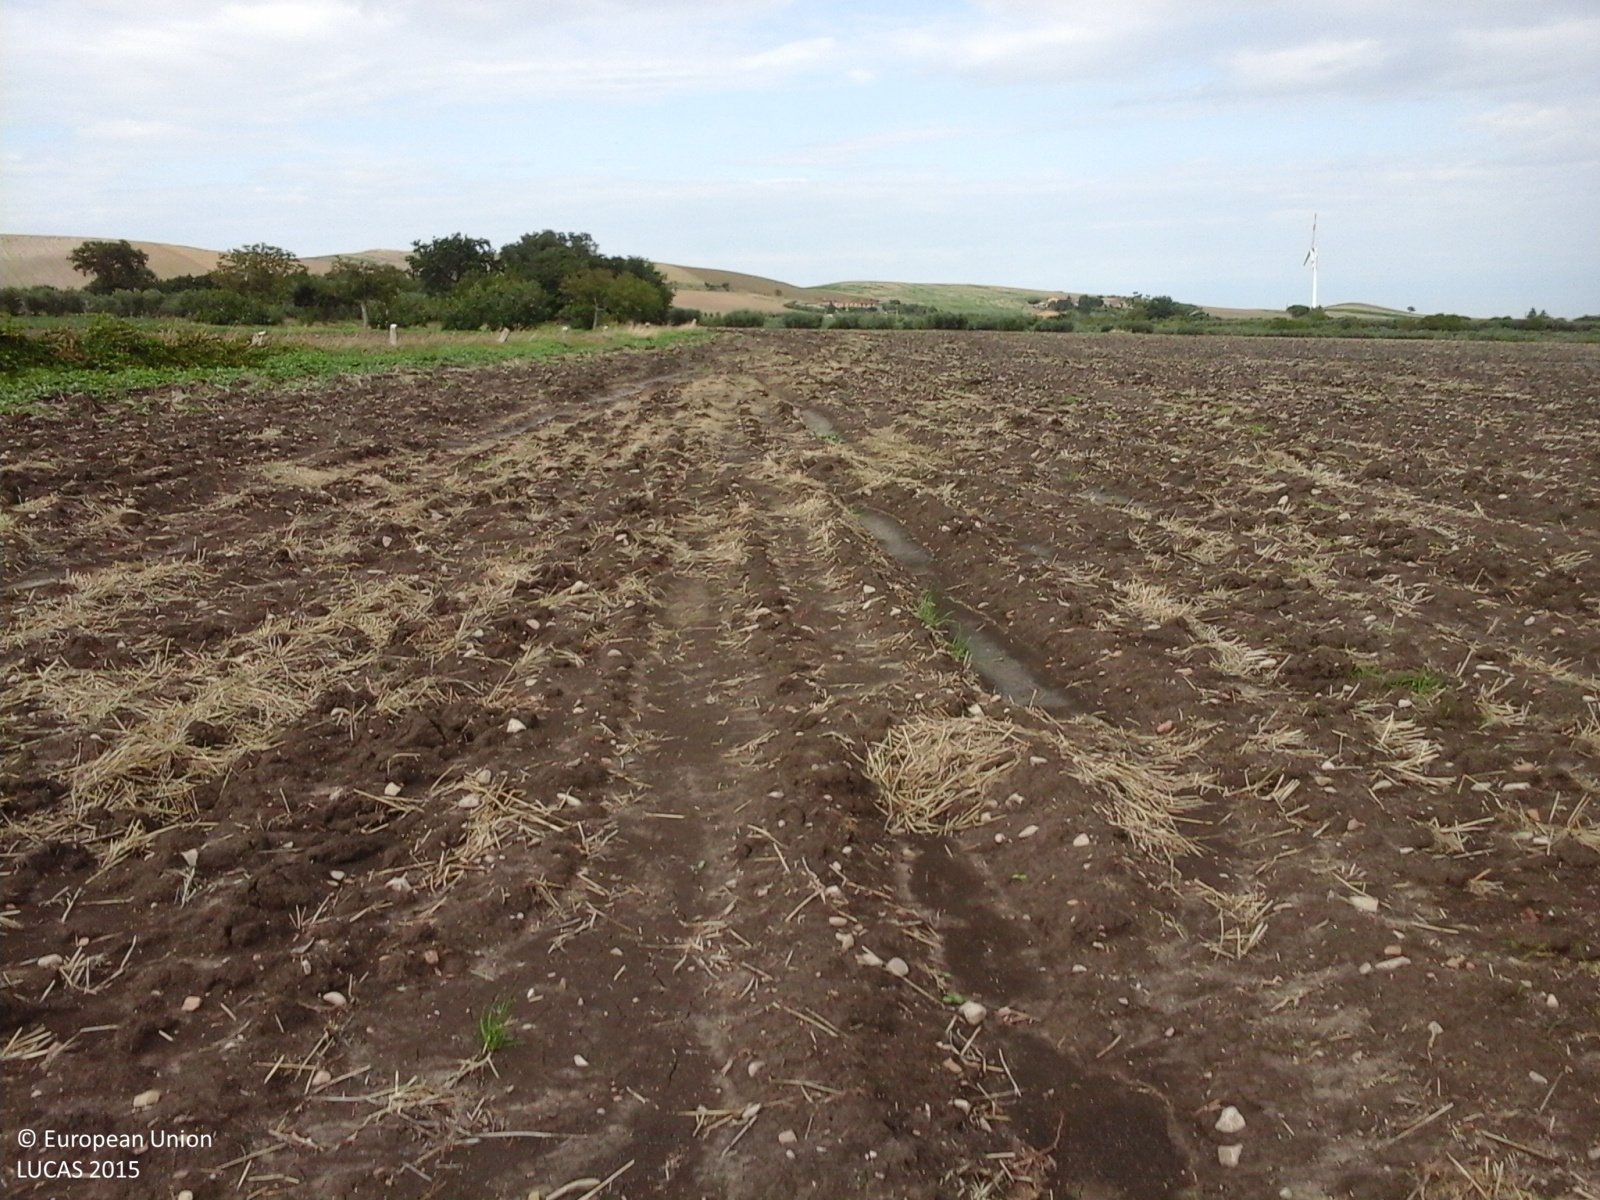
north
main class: Cropland
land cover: Durum wheat
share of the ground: > 75 %
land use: Agriculture (excluding fallow land and kitchen gardens)
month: October
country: IT
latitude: 41.5443
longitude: 15.1734
